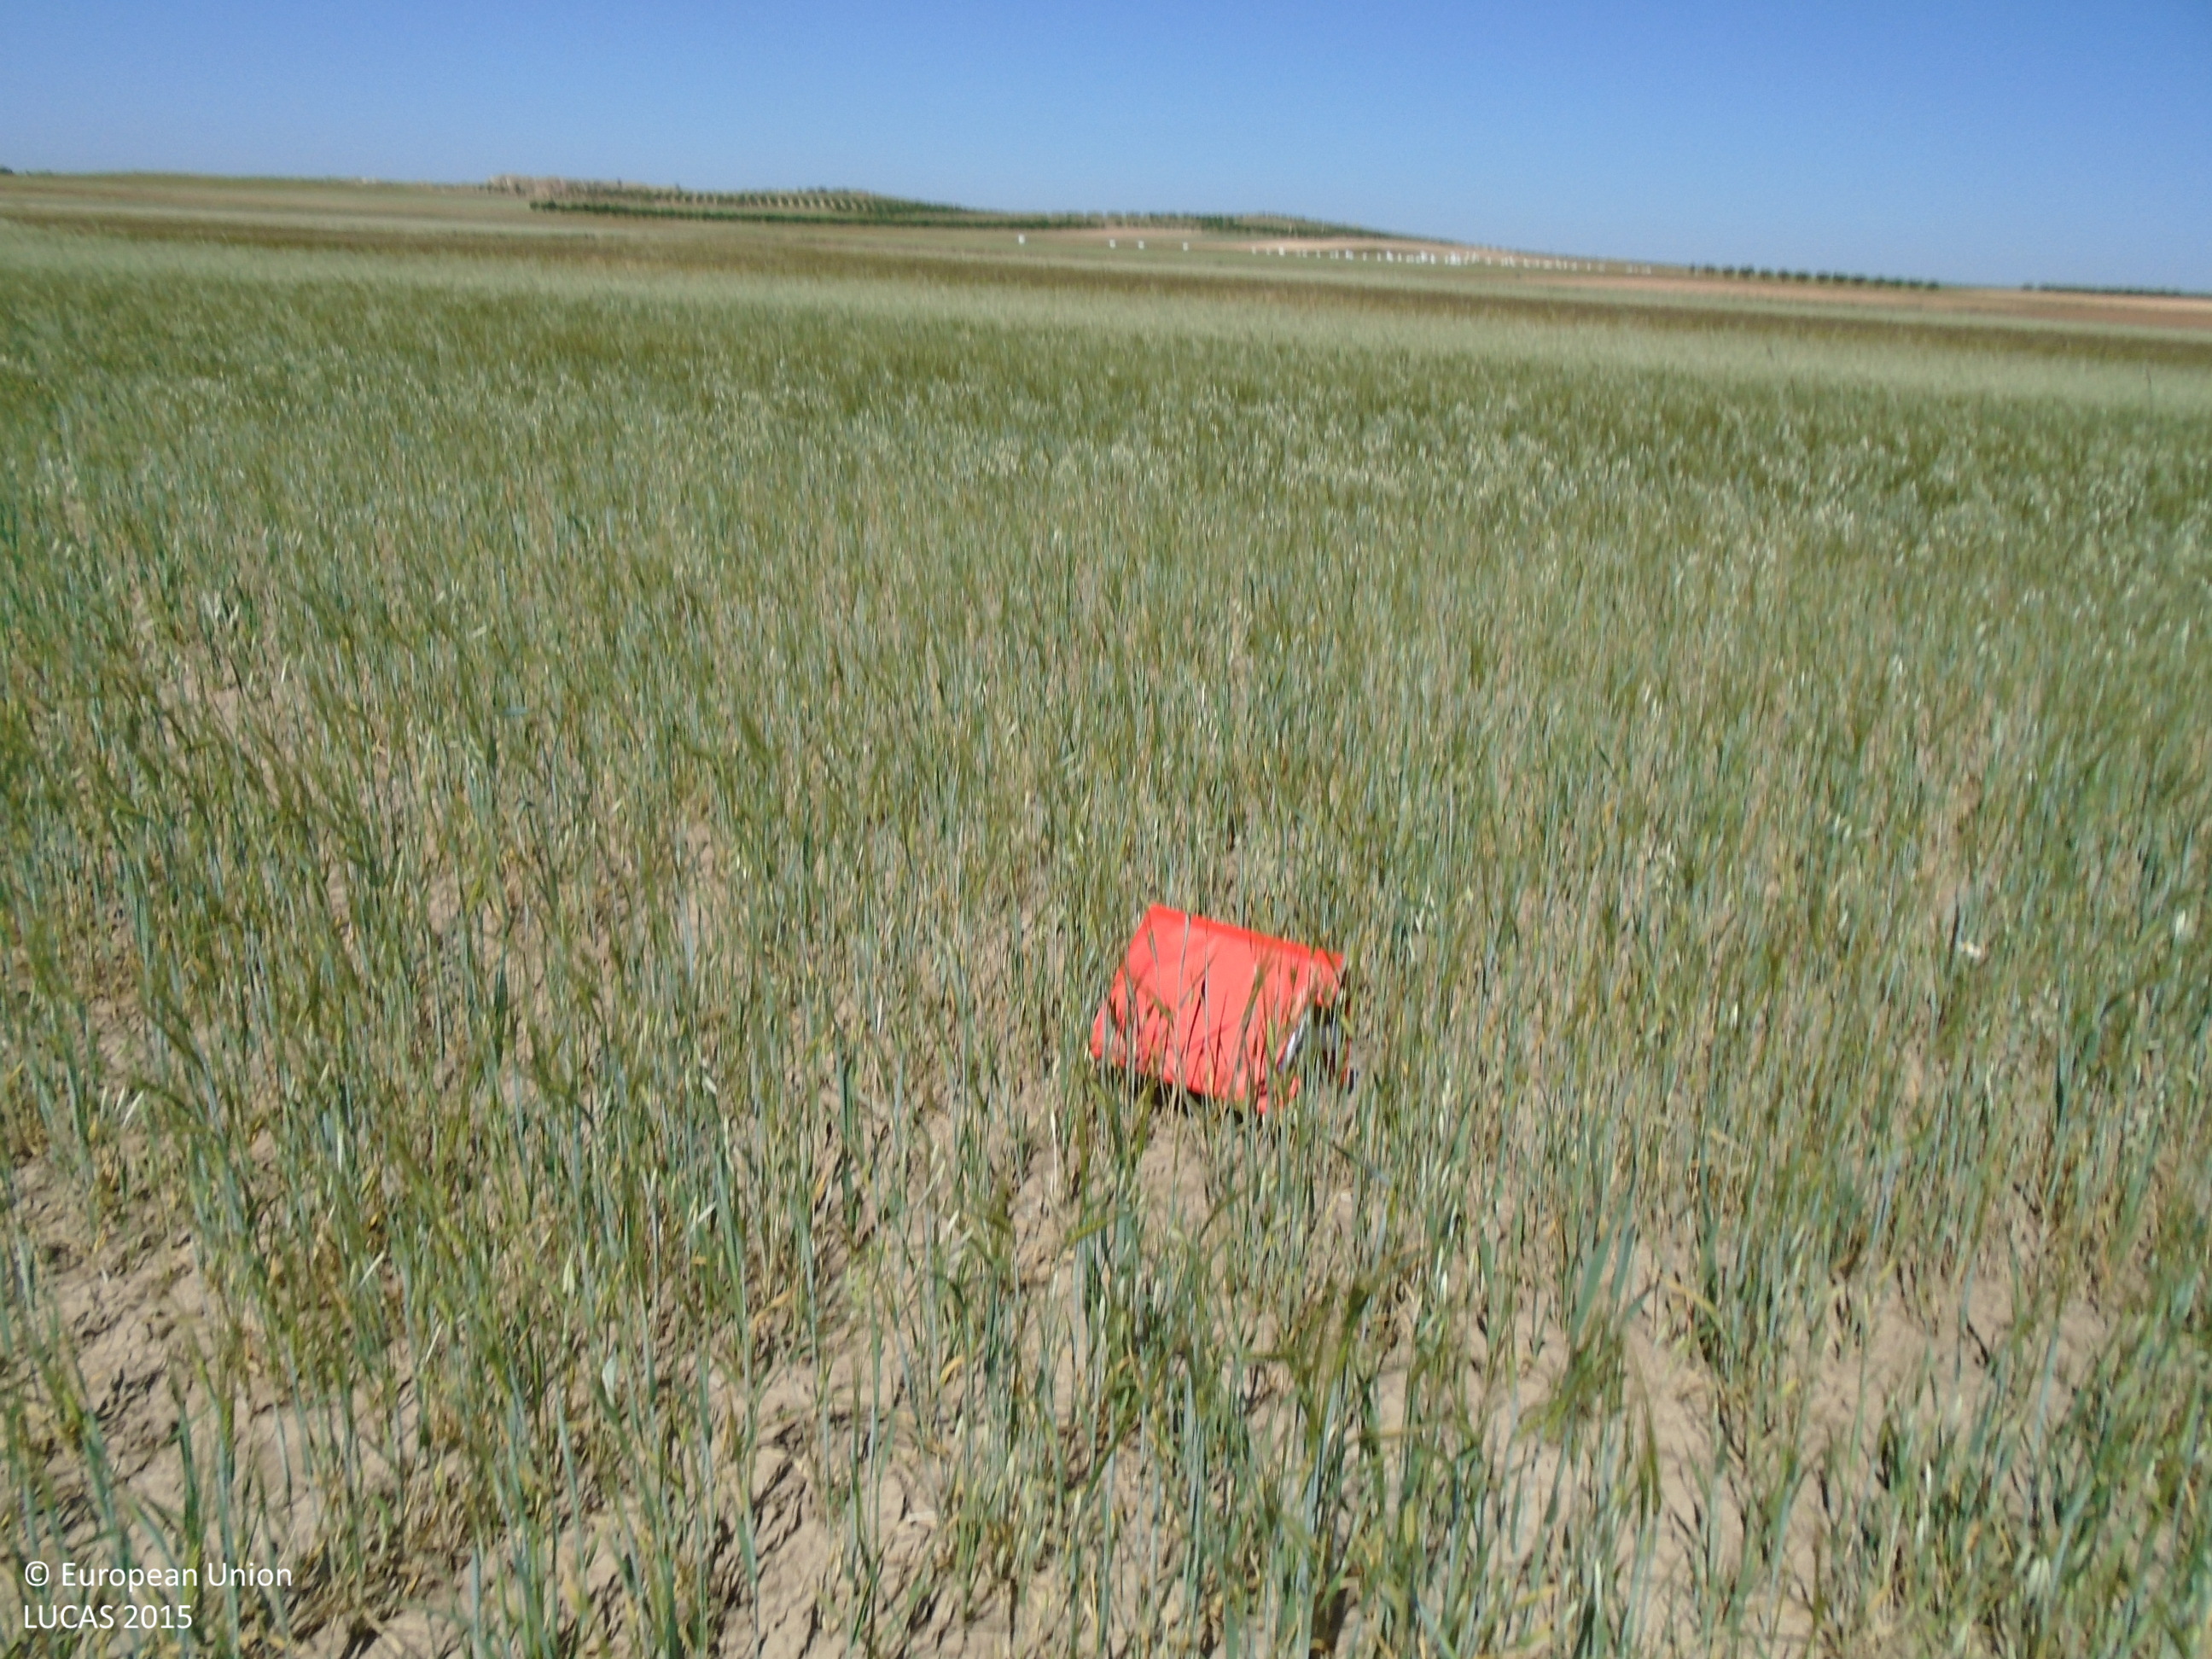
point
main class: Cropland
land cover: Common wheat
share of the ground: > 75 %
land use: Agriculture (excluding fallow land and kitchen gardens)
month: May
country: ES
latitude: 39.7484
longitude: -3.6475
